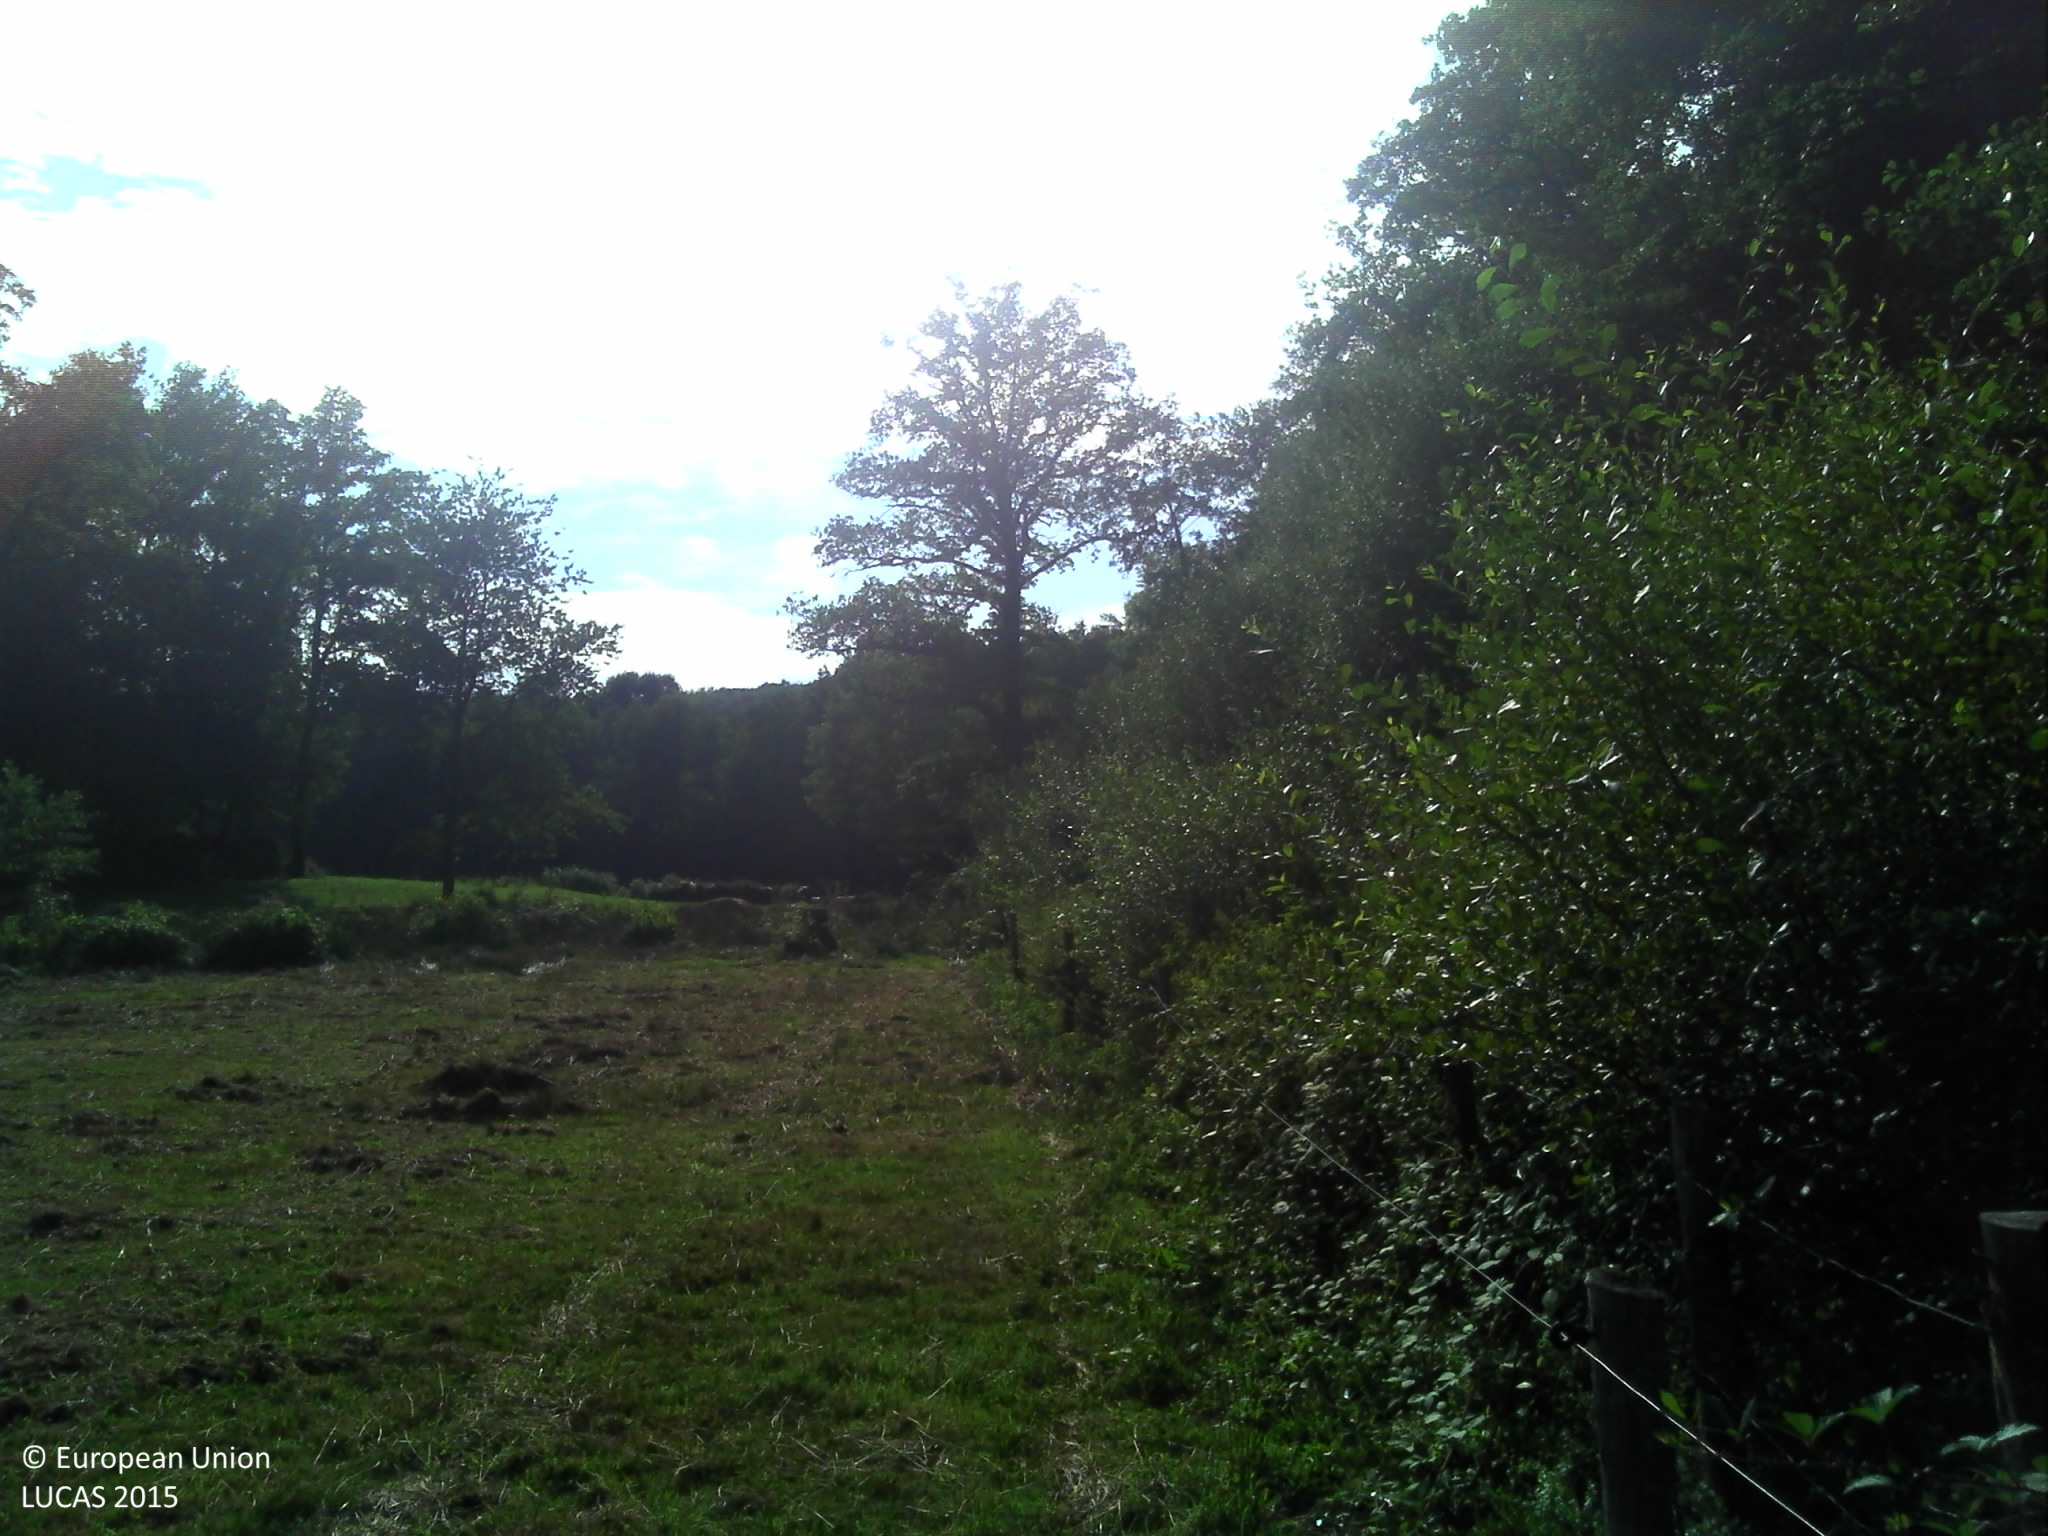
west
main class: Woodland
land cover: Broadleaved woodland
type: floodplain forest
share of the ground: > 75 %
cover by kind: broadleaved forest trees 70 %, shrubs 15 %, herbaceous plants 15 %
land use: Forestry
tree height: > 5 m
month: August
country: FR
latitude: 46.1782
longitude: 1.7666
